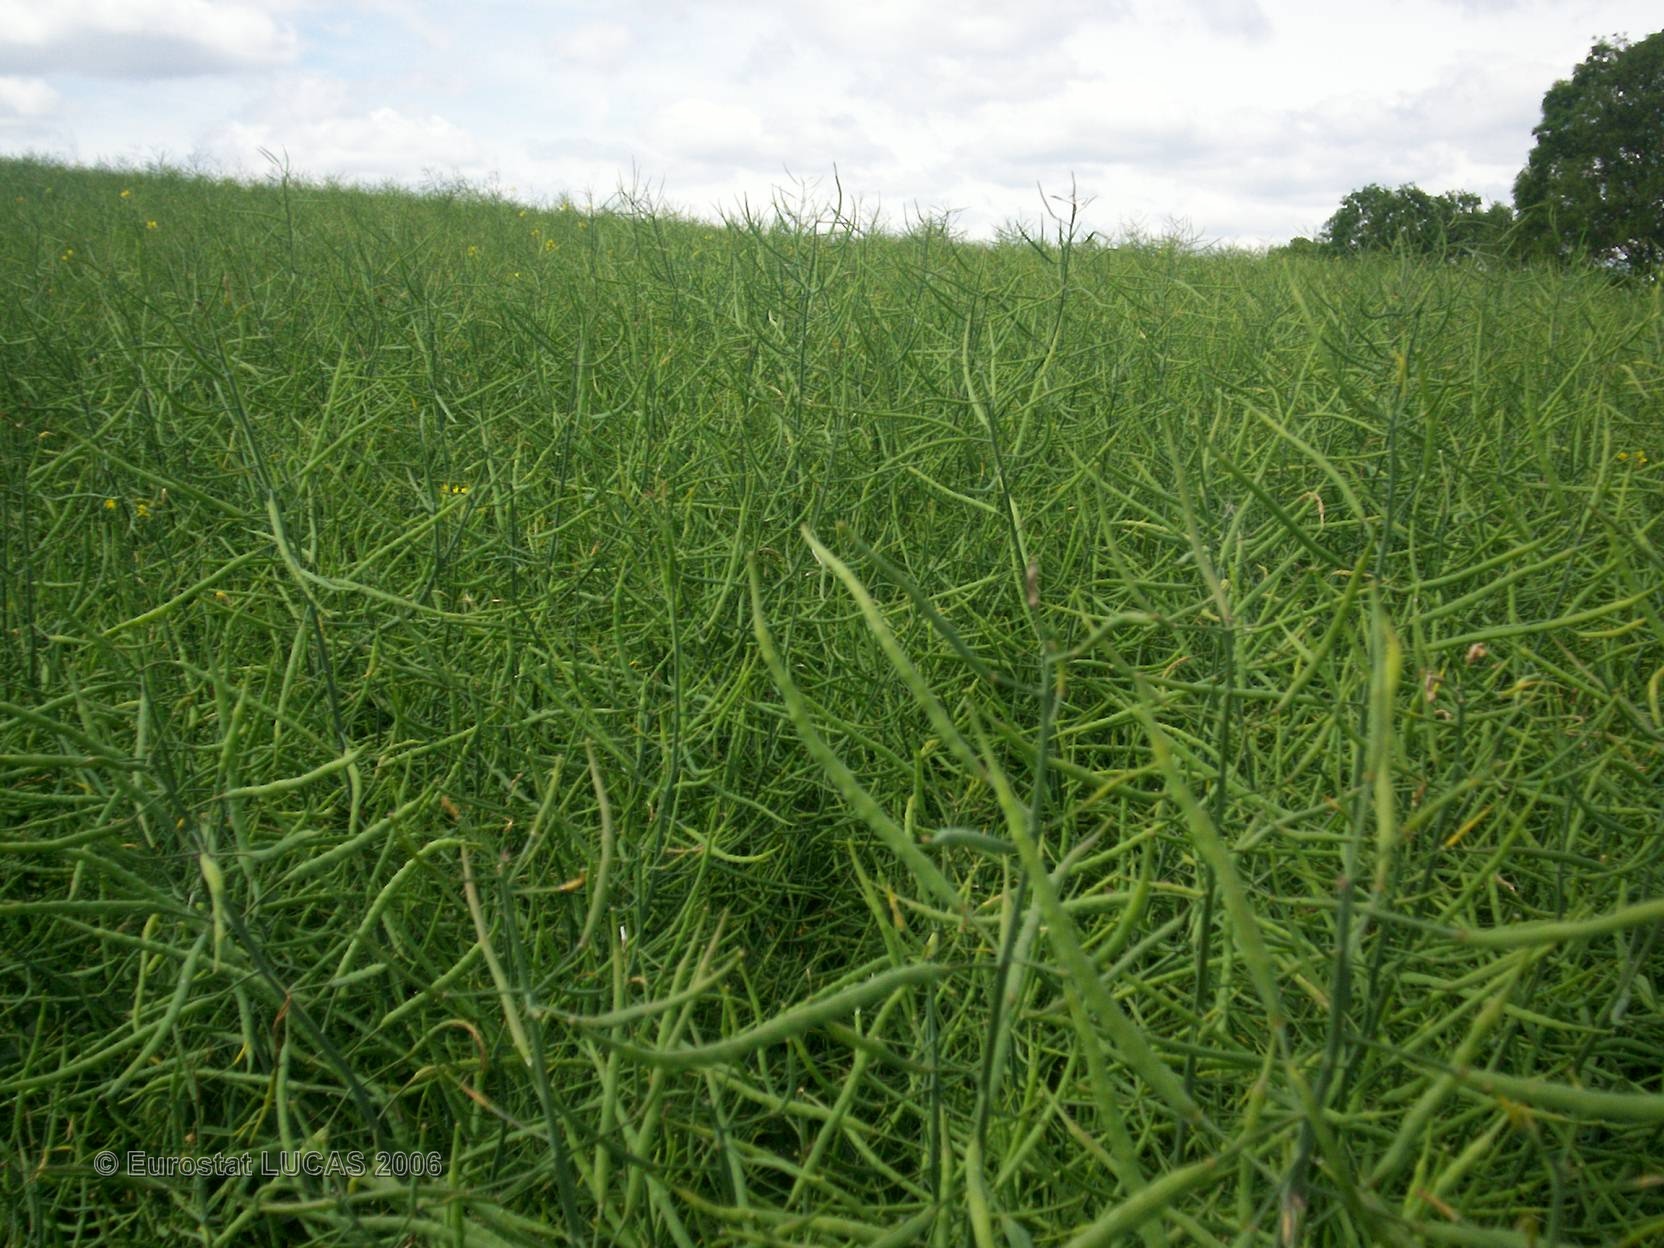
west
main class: Cropland
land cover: Rape and turnip rape
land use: Agriculture (excluding fallow land and kitchen gardens)
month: June
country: FR
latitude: 49.2307
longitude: 5.0679
